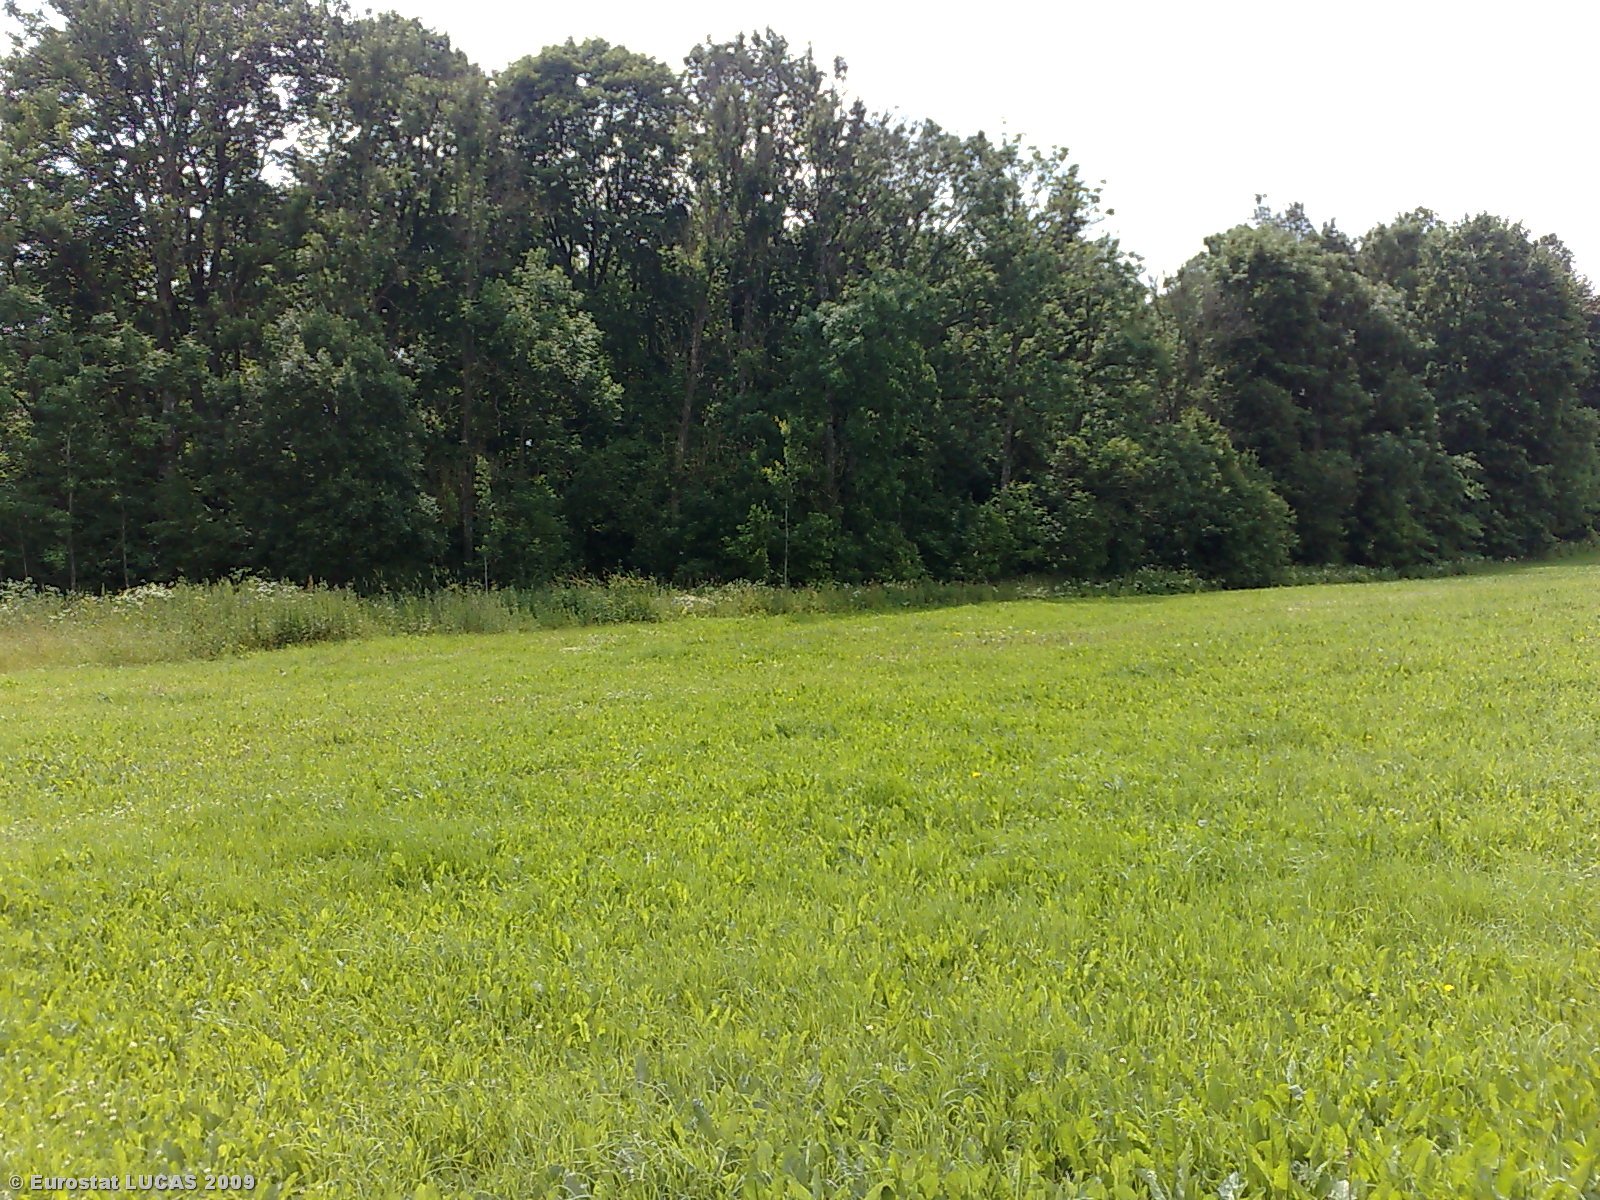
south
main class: Grassland
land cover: Grassland without tree/shrub cover
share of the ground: > 75 %
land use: Agriculture (excluding fallow land and kitchen gardens)
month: July
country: LT
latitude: 55.5826
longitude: 22.7724
